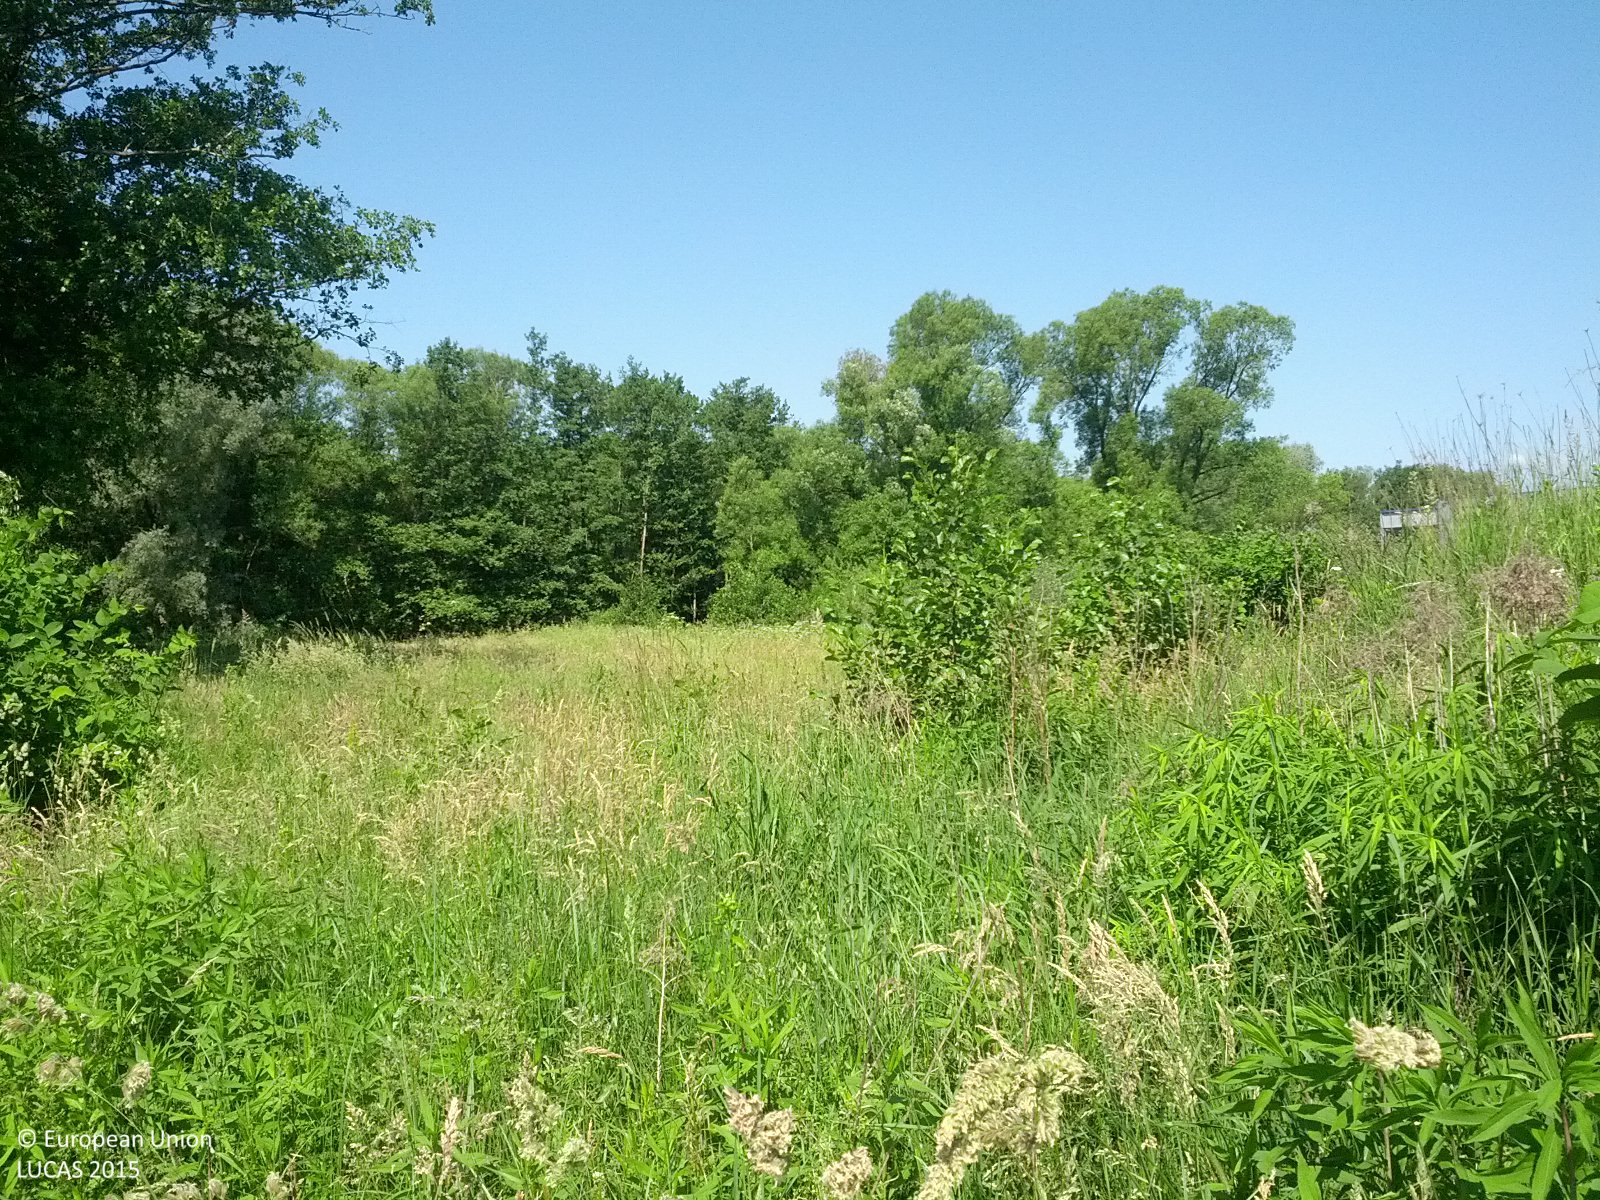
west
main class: Grassland
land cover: Grassland without tree/shrub cover
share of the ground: > 75 %
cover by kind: herbaceous plants 90 %, shrubs 5 %, unconsolidated bare surface 5 %
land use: Abandoned areas
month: June
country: AT
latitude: 47.1667
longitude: 16.1626
